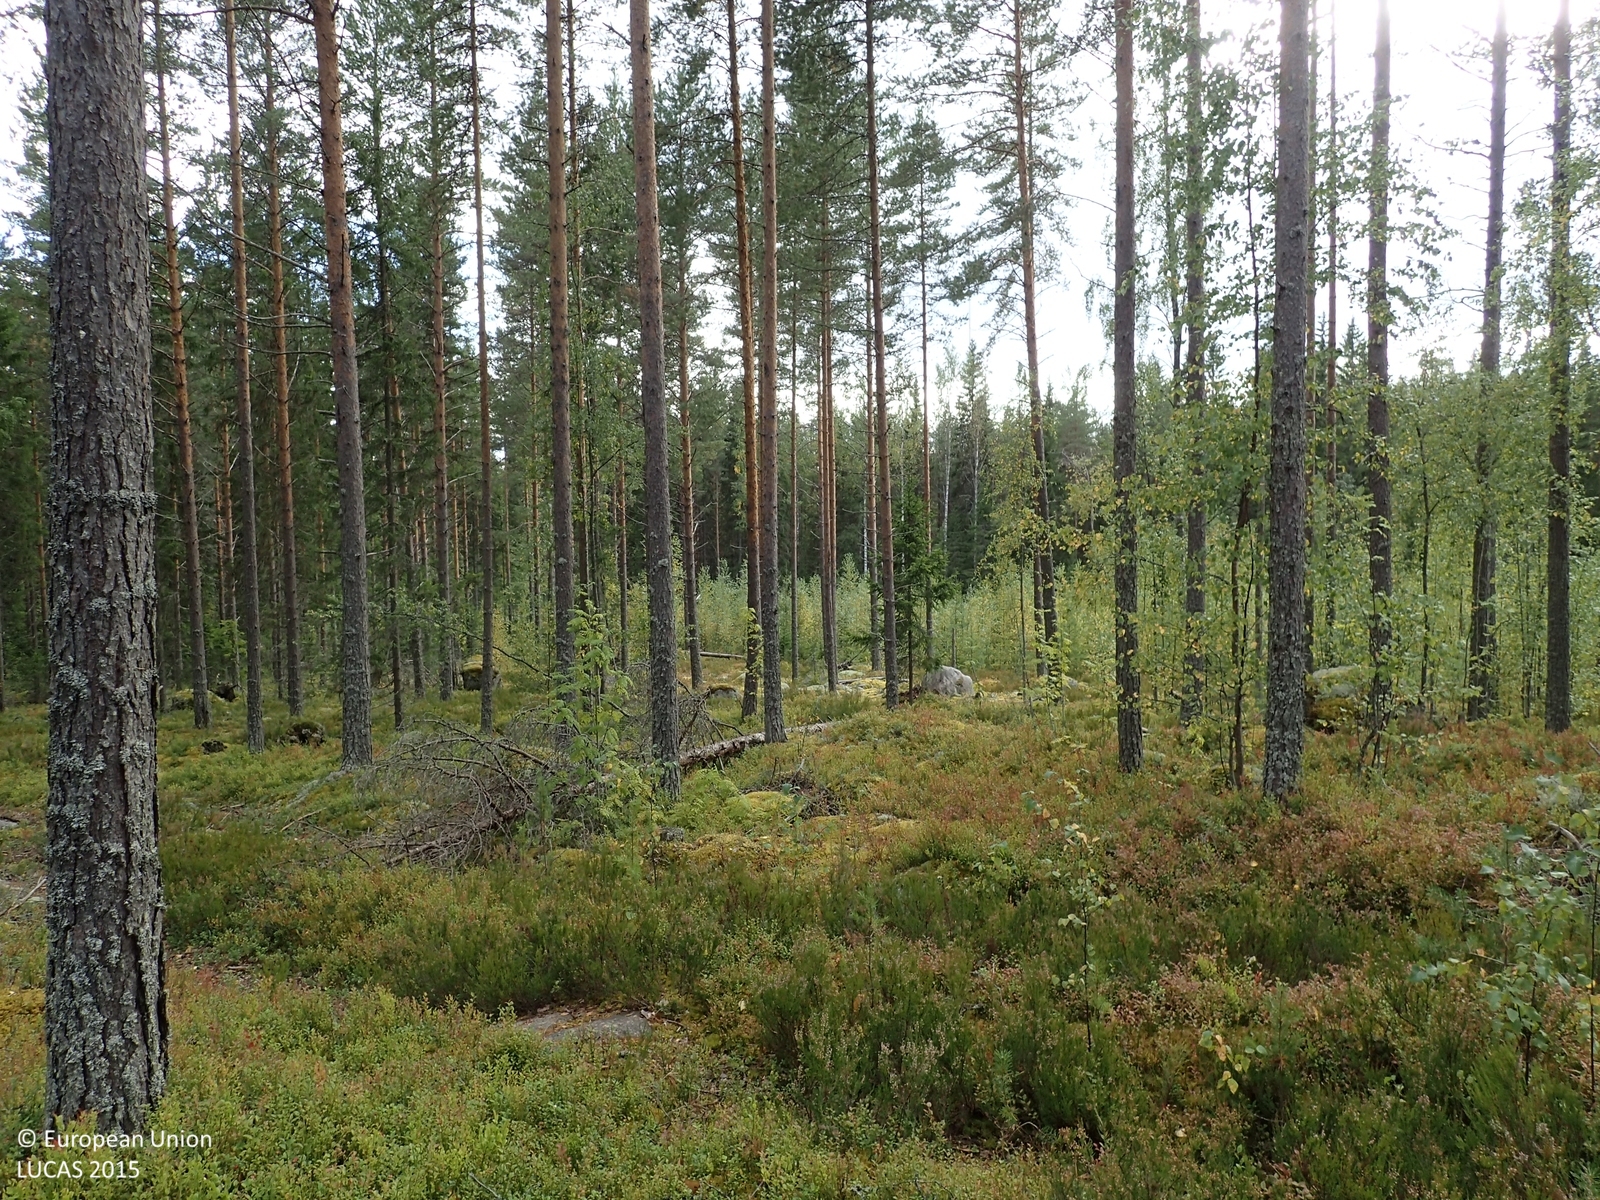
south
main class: Woodland
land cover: Pine dominated mixed woodland
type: boreal forest
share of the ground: 50 - 75 %
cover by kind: coniferous forest trees 45 %, shrubs 30 %, broadleaved forest trees 15 %, lichens and mosses 10 %
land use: Forestry
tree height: > 5 m
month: September
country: FI
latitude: 63.1809
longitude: 25.9087
